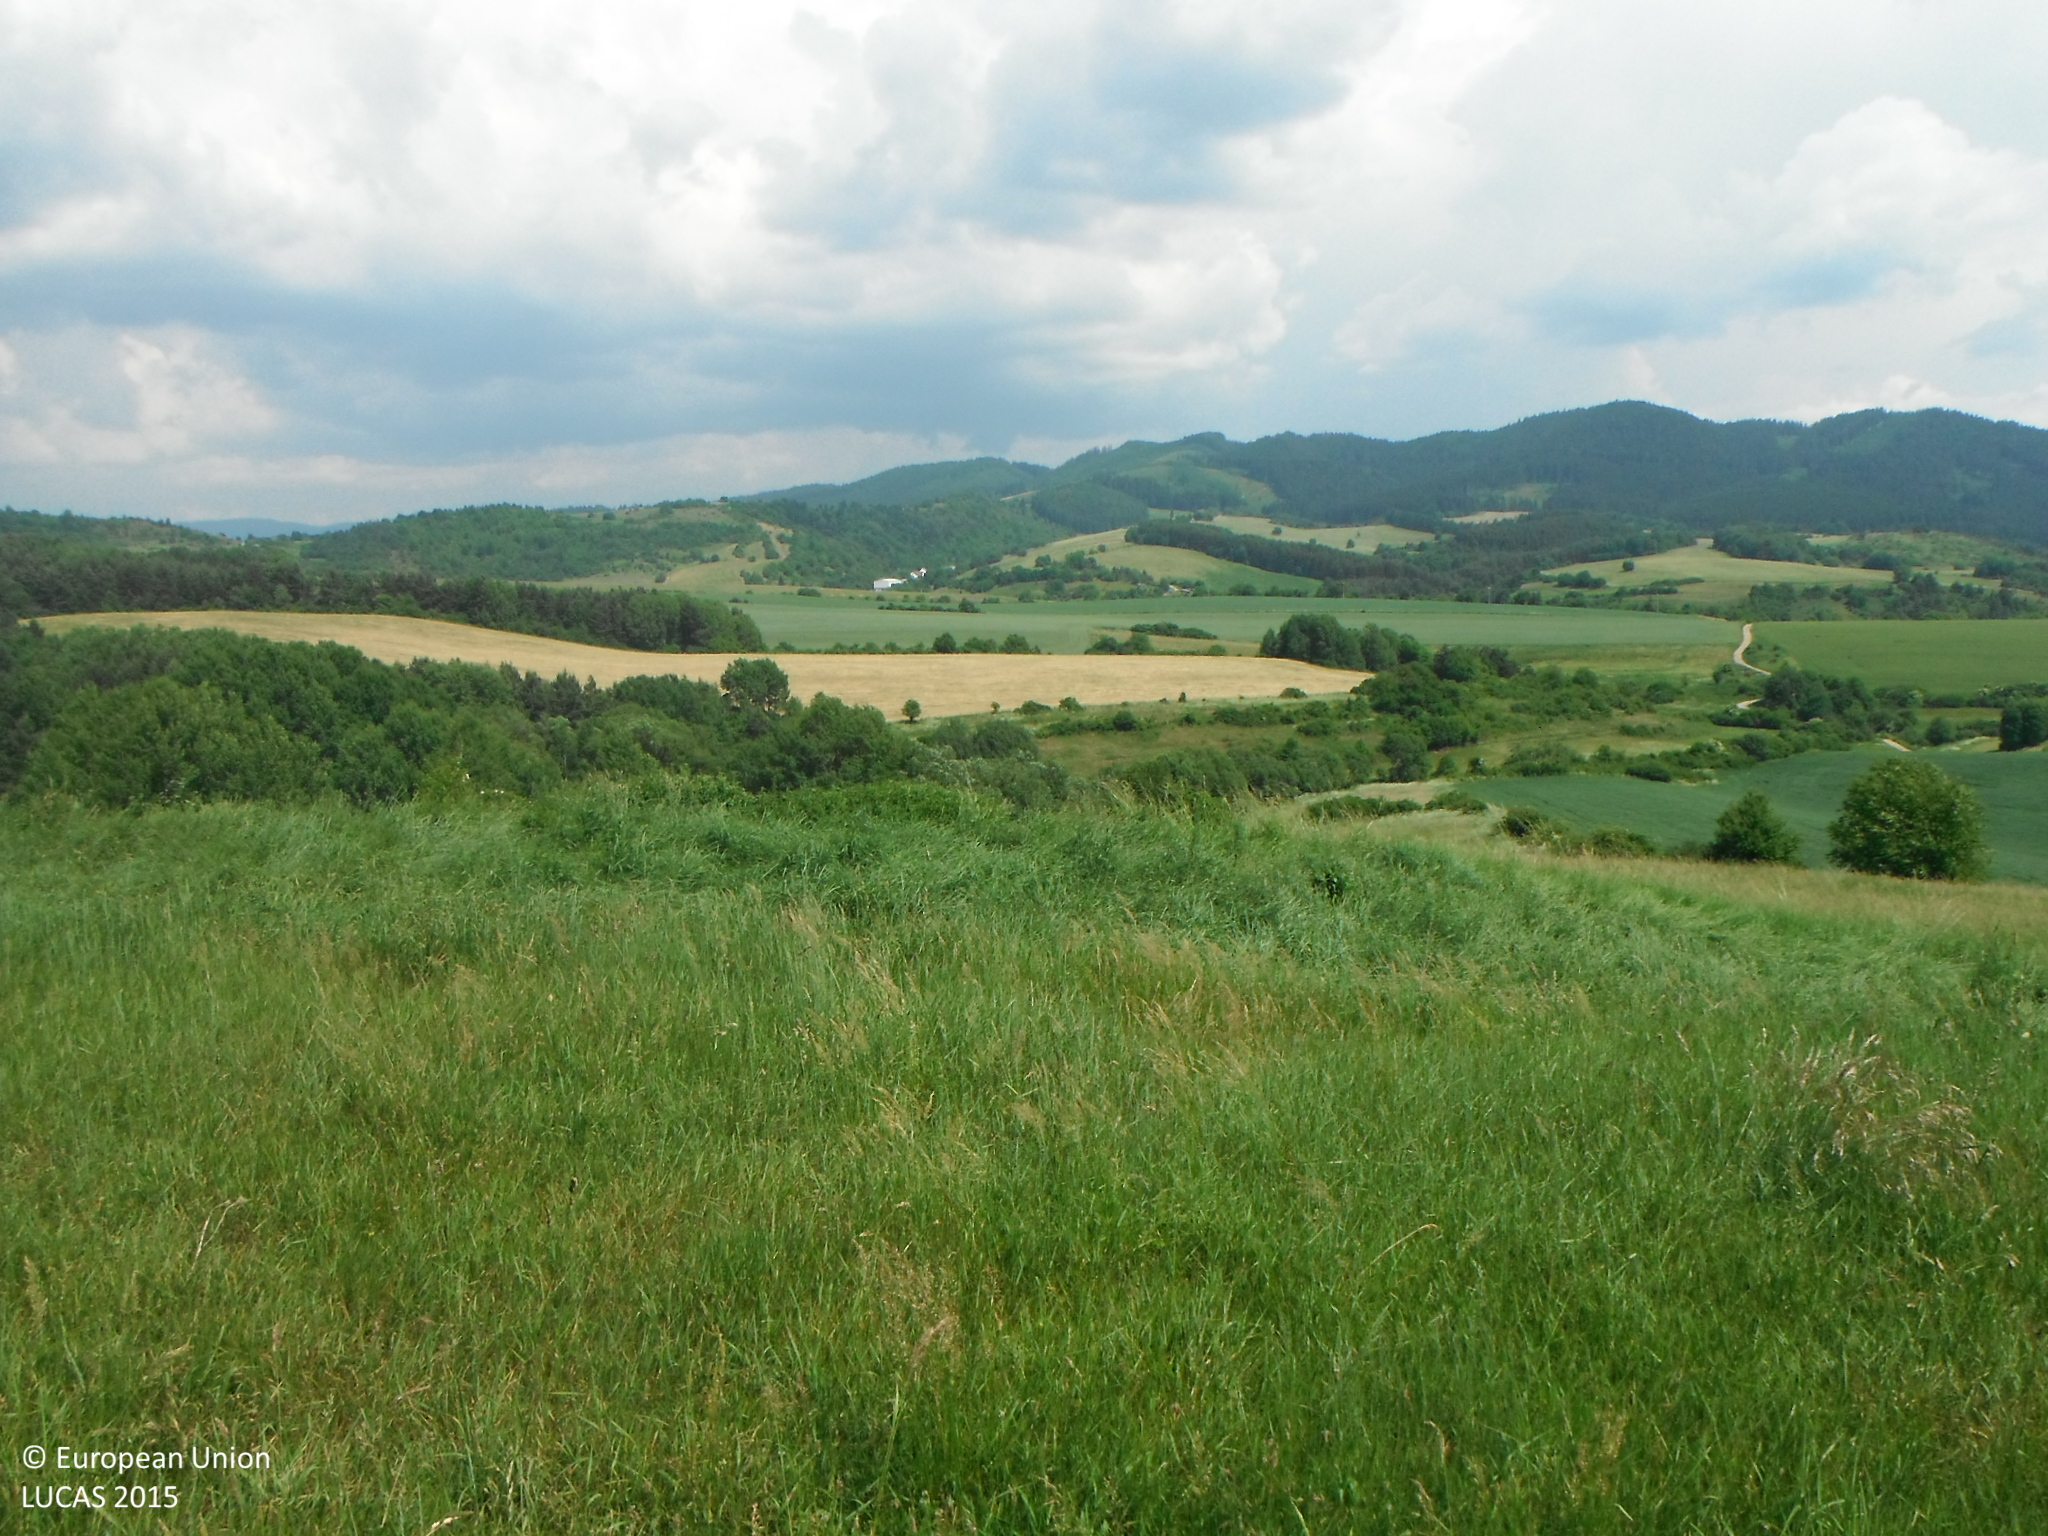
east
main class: Grassland
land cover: Grassland without tree/shrub cover
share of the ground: > 75 %
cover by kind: herbaceous plants 100 %
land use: Agriculture (excluding fallow land and kitchen gardens)
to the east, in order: Grassland without tree/shrub cover; Broadleaved woodland; Ditches and canals; Broadleaved woodland; Grassland without tree/shrub cover
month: June
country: SK
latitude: 48.7188
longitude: 19.2798
